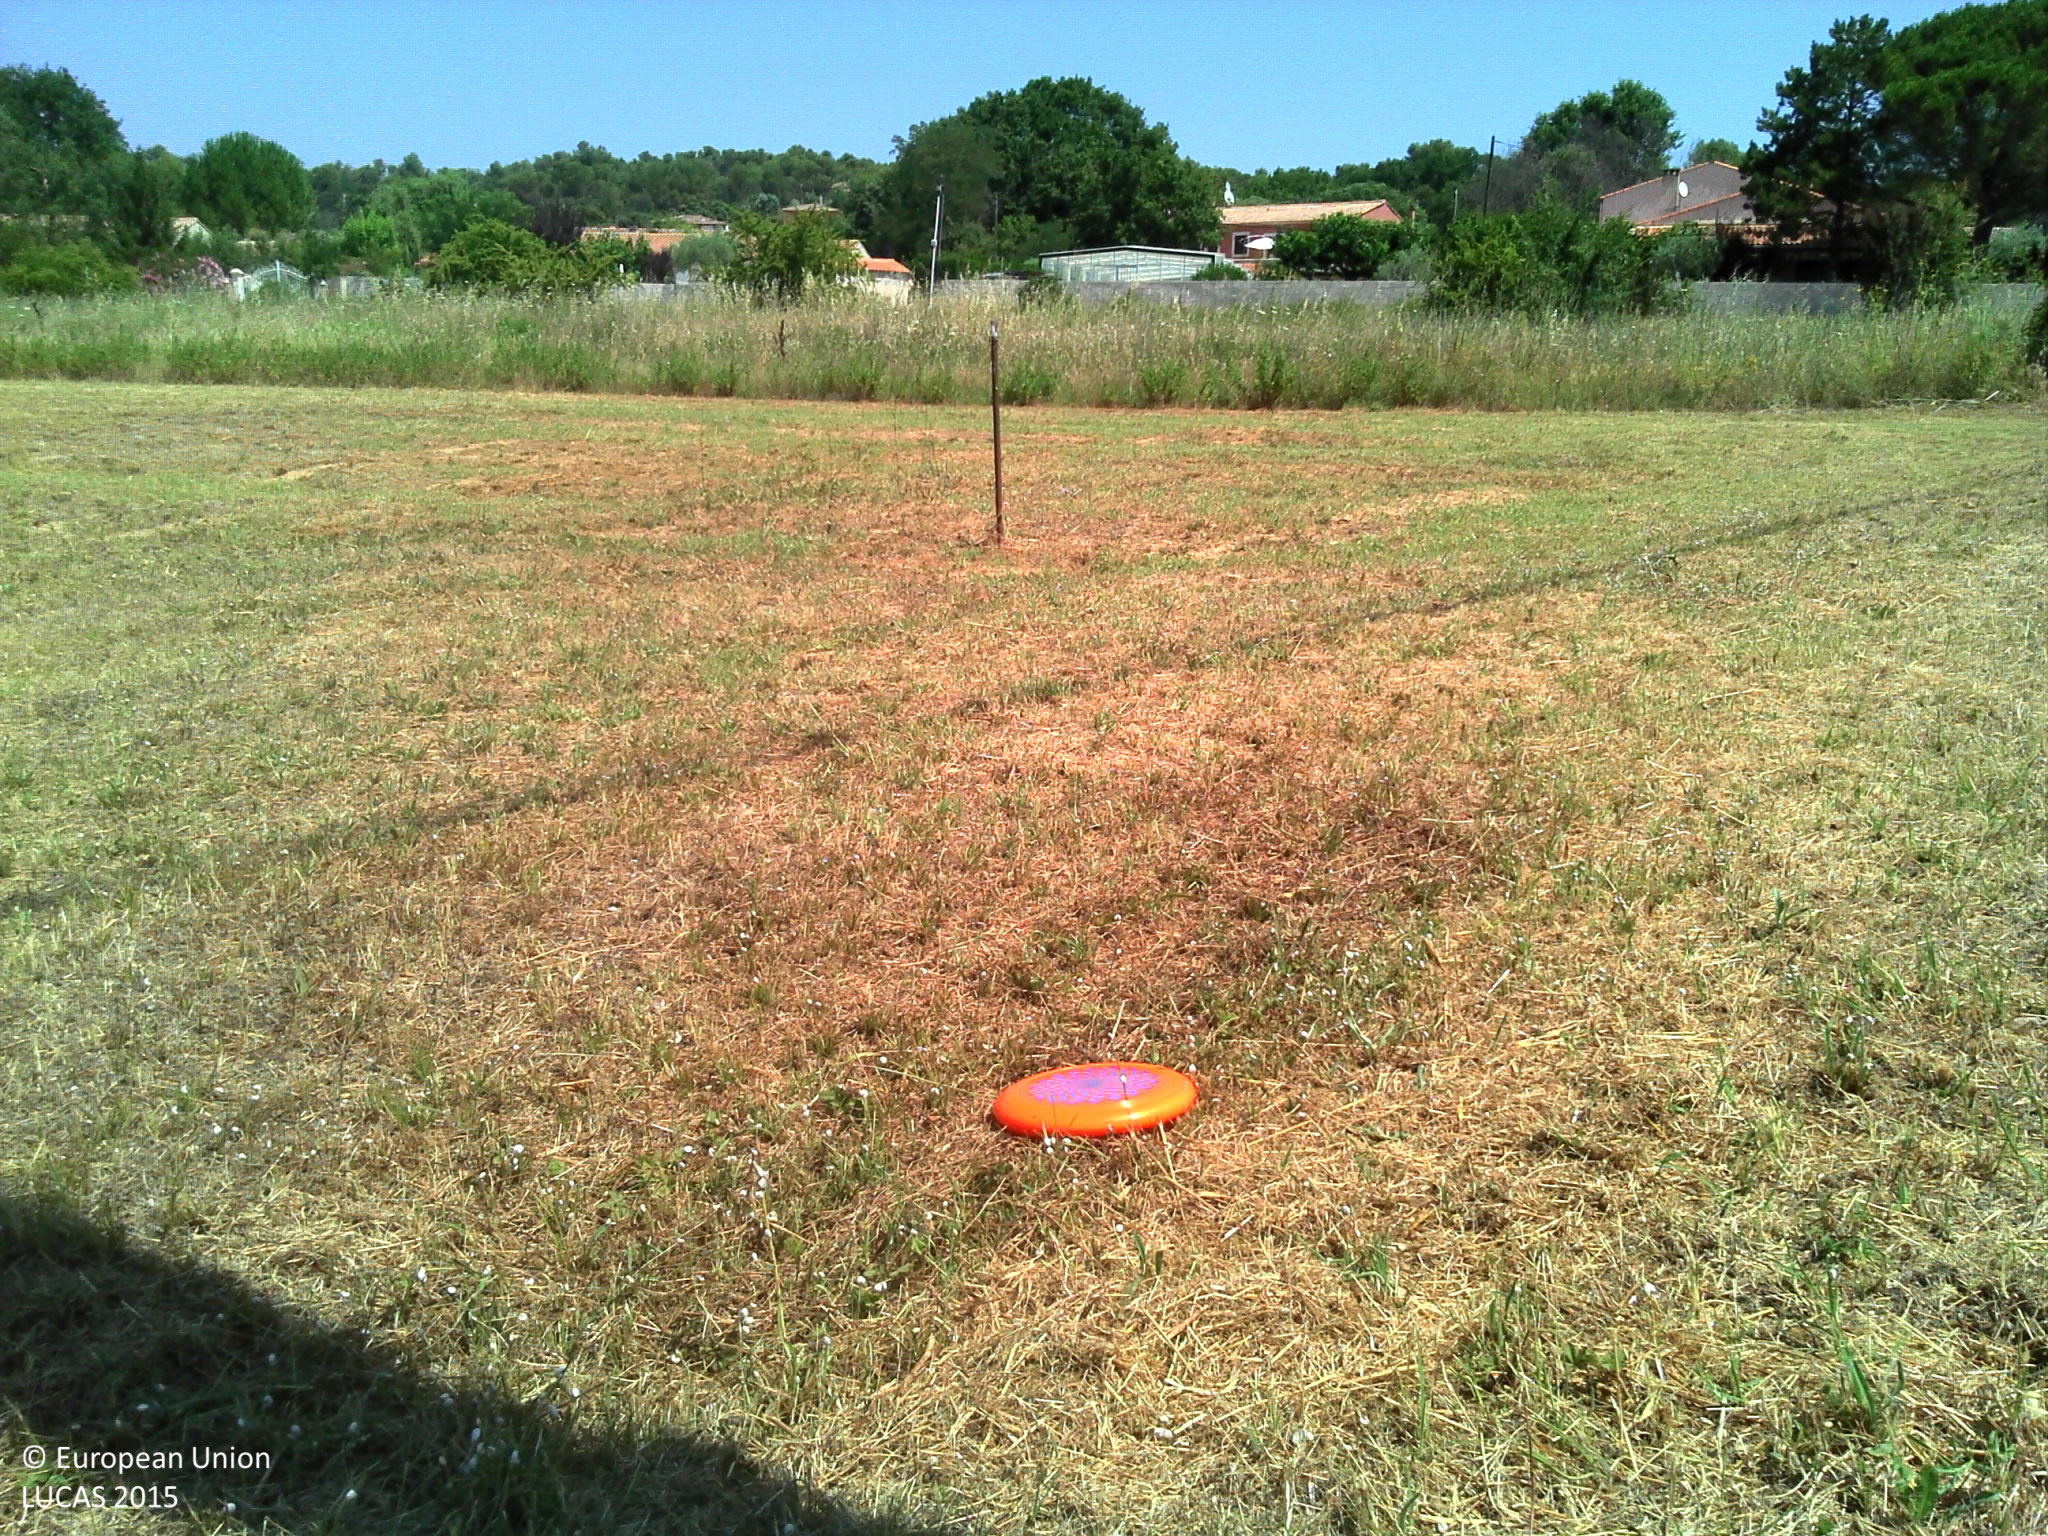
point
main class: Grassland
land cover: Grassland without tree/shrub cover
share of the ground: > 75 %
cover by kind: herbaceous plants 100 %
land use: Agriculture (excluding fallow land and kitchen gardens)
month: July
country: FR
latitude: 43.5045
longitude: 5.7424
